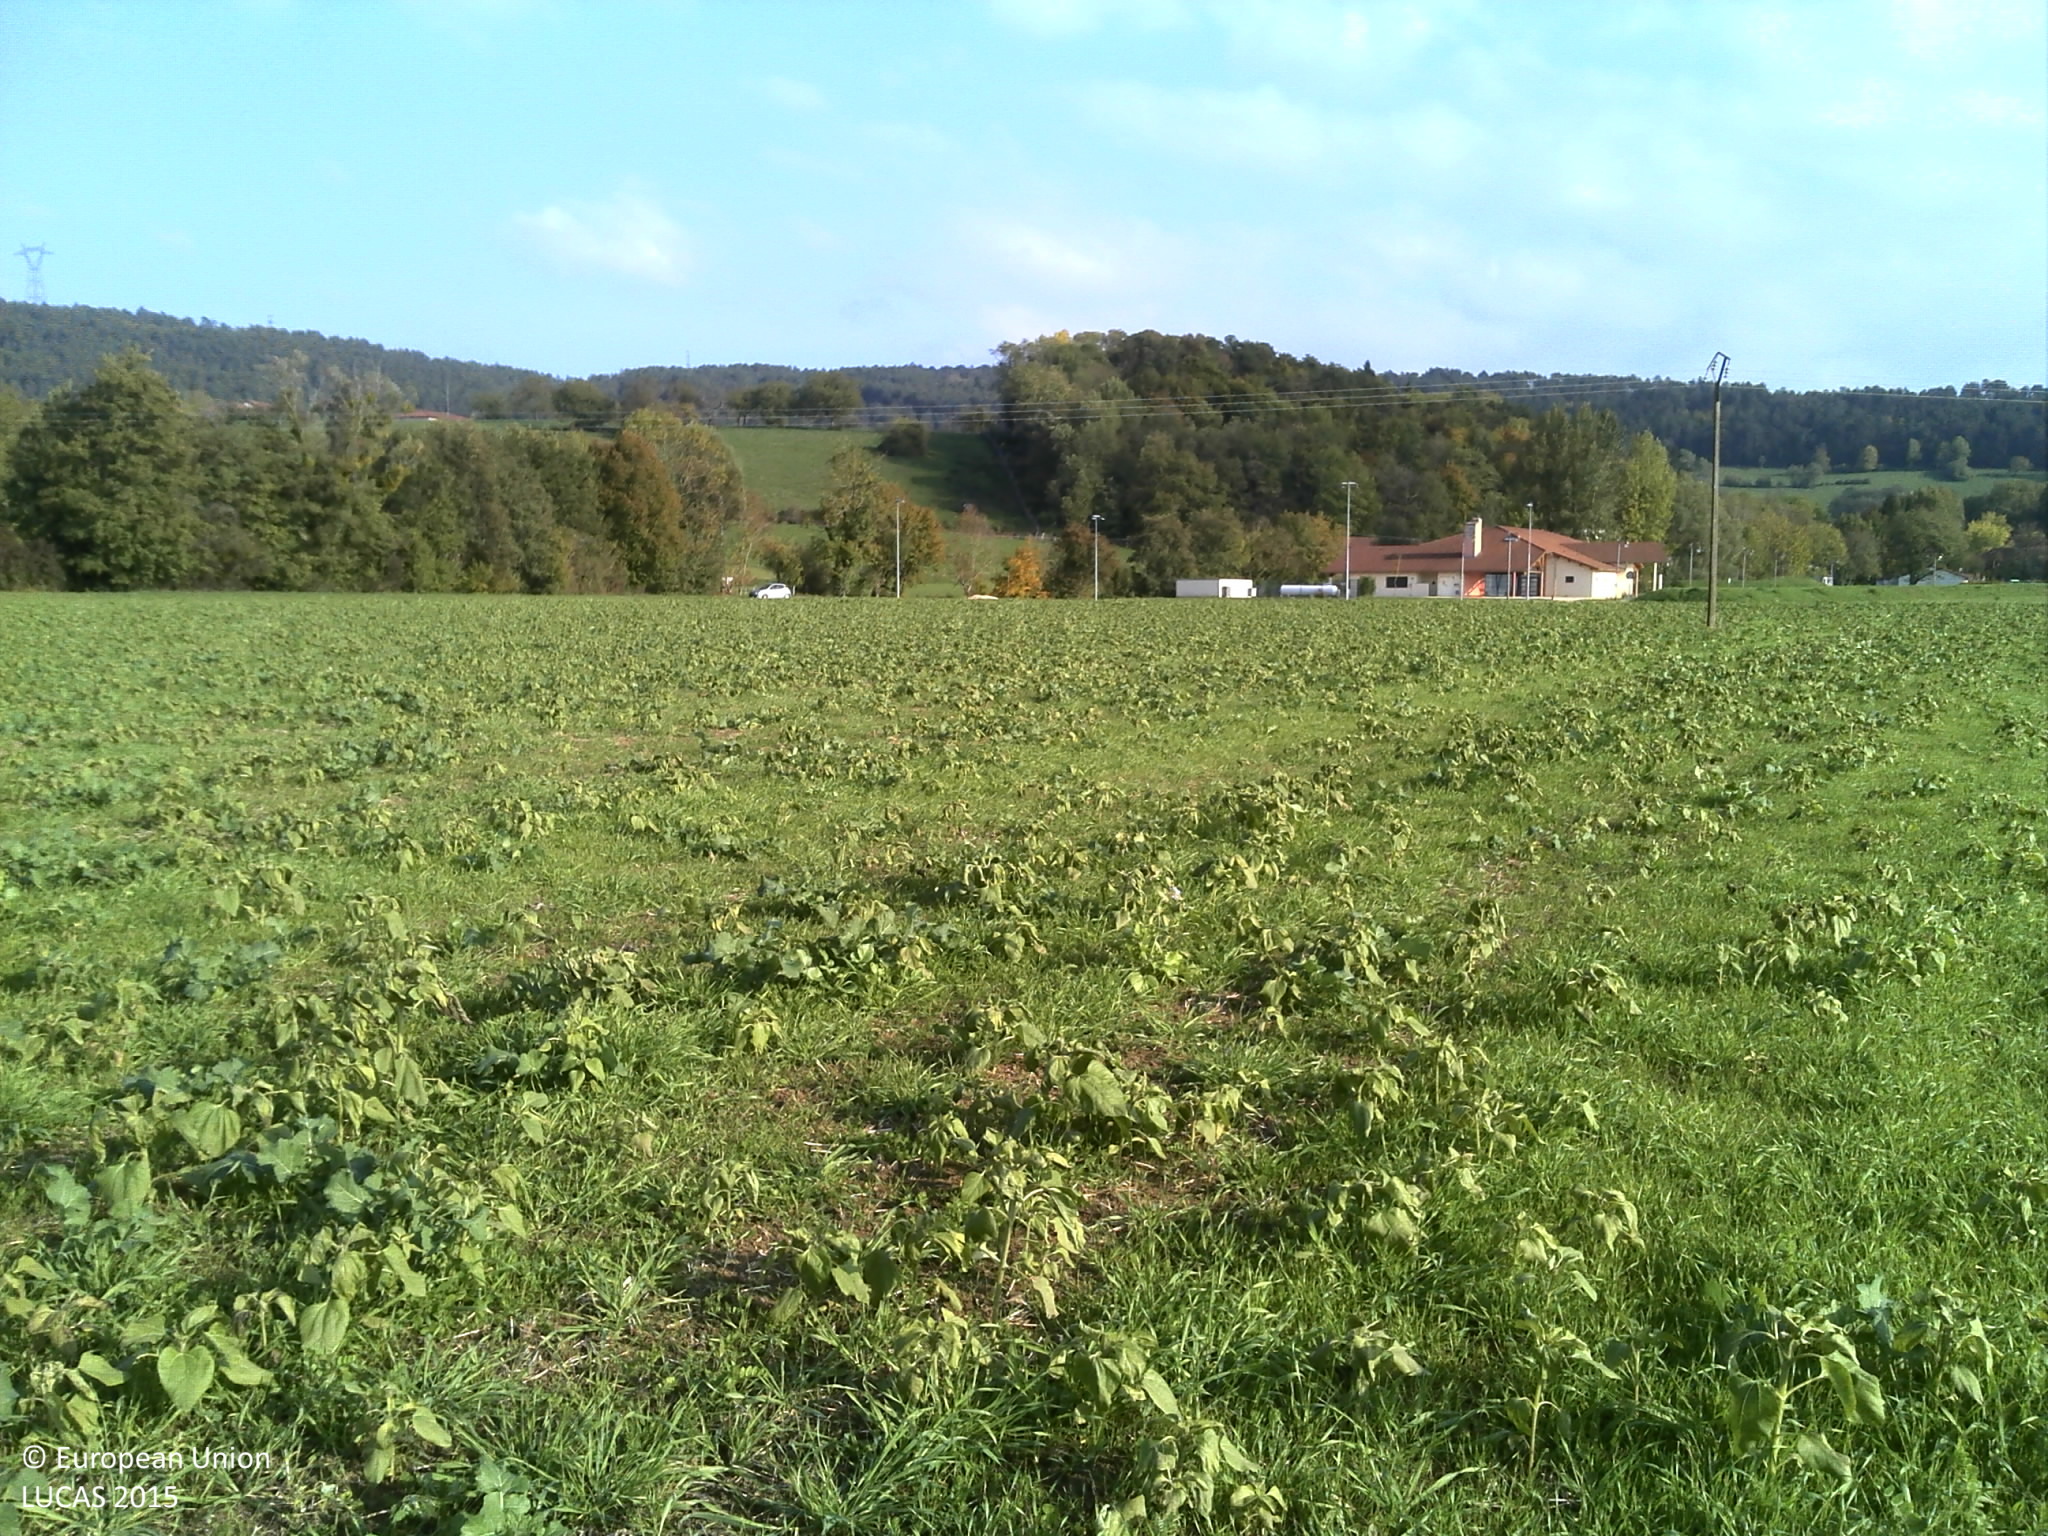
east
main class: Cropland
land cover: Sunflower
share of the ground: 10 - 25 %
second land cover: Spontaneously vegetated surfaces
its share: > 75 %
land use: Agriculture (excluding fallow land and kitchen gardens)
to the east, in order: Sunflower; Spontaneously vegetated surfaces; Electric lines; Sunflower; Grassland without tree/shrub cover; Broadleaved woodland; Rivers and streams; Broadleaved woodland; Grassland without tree/shrub cover; Electric lines; Grassland without tree/shrub cover; Paved roads, cycling and walking lanes; Grass margins; Common wheat
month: October
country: FR
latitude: 46.2500
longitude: 5.3464
